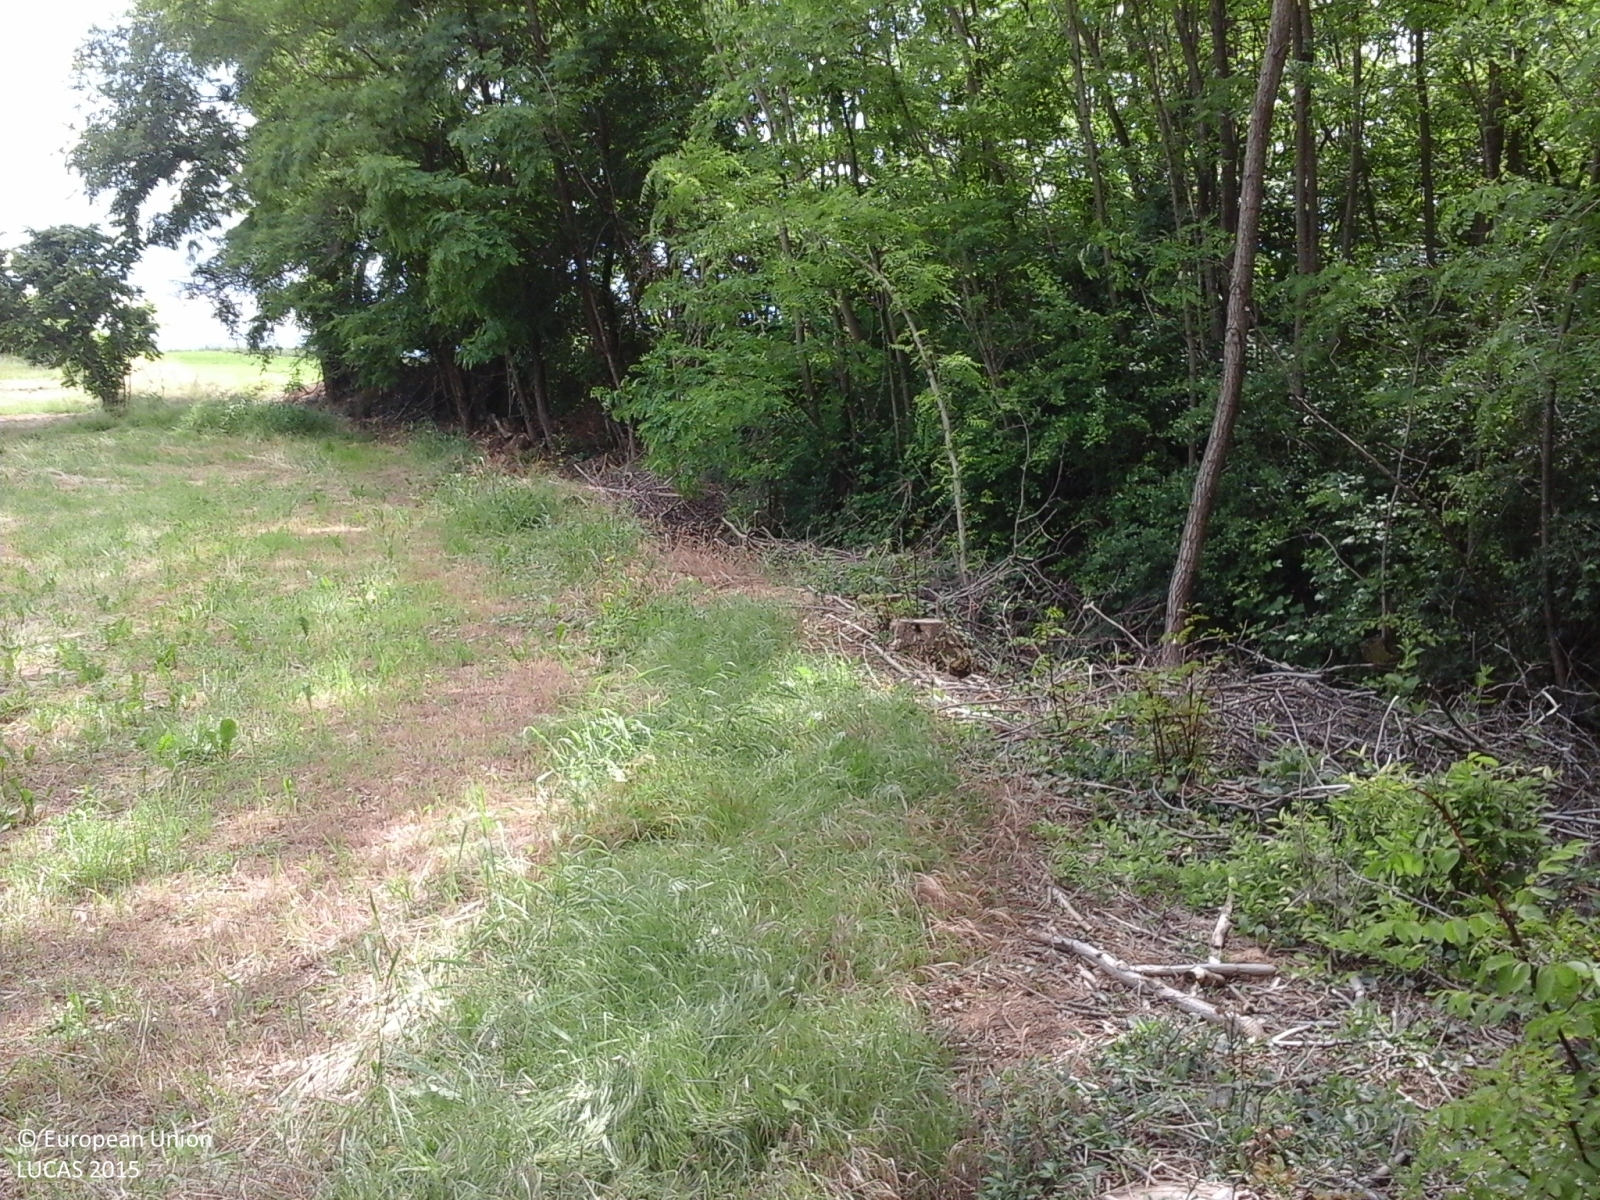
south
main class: Woodland
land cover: Broadleaved woodland
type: thermophilous deciduous forest
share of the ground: > 75 %
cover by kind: broadleaved forest trees 100 %
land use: Semi-natural and natural areas not in use
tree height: > 5 m
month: May
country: IT
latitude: 44.4722
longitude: 7.8298
